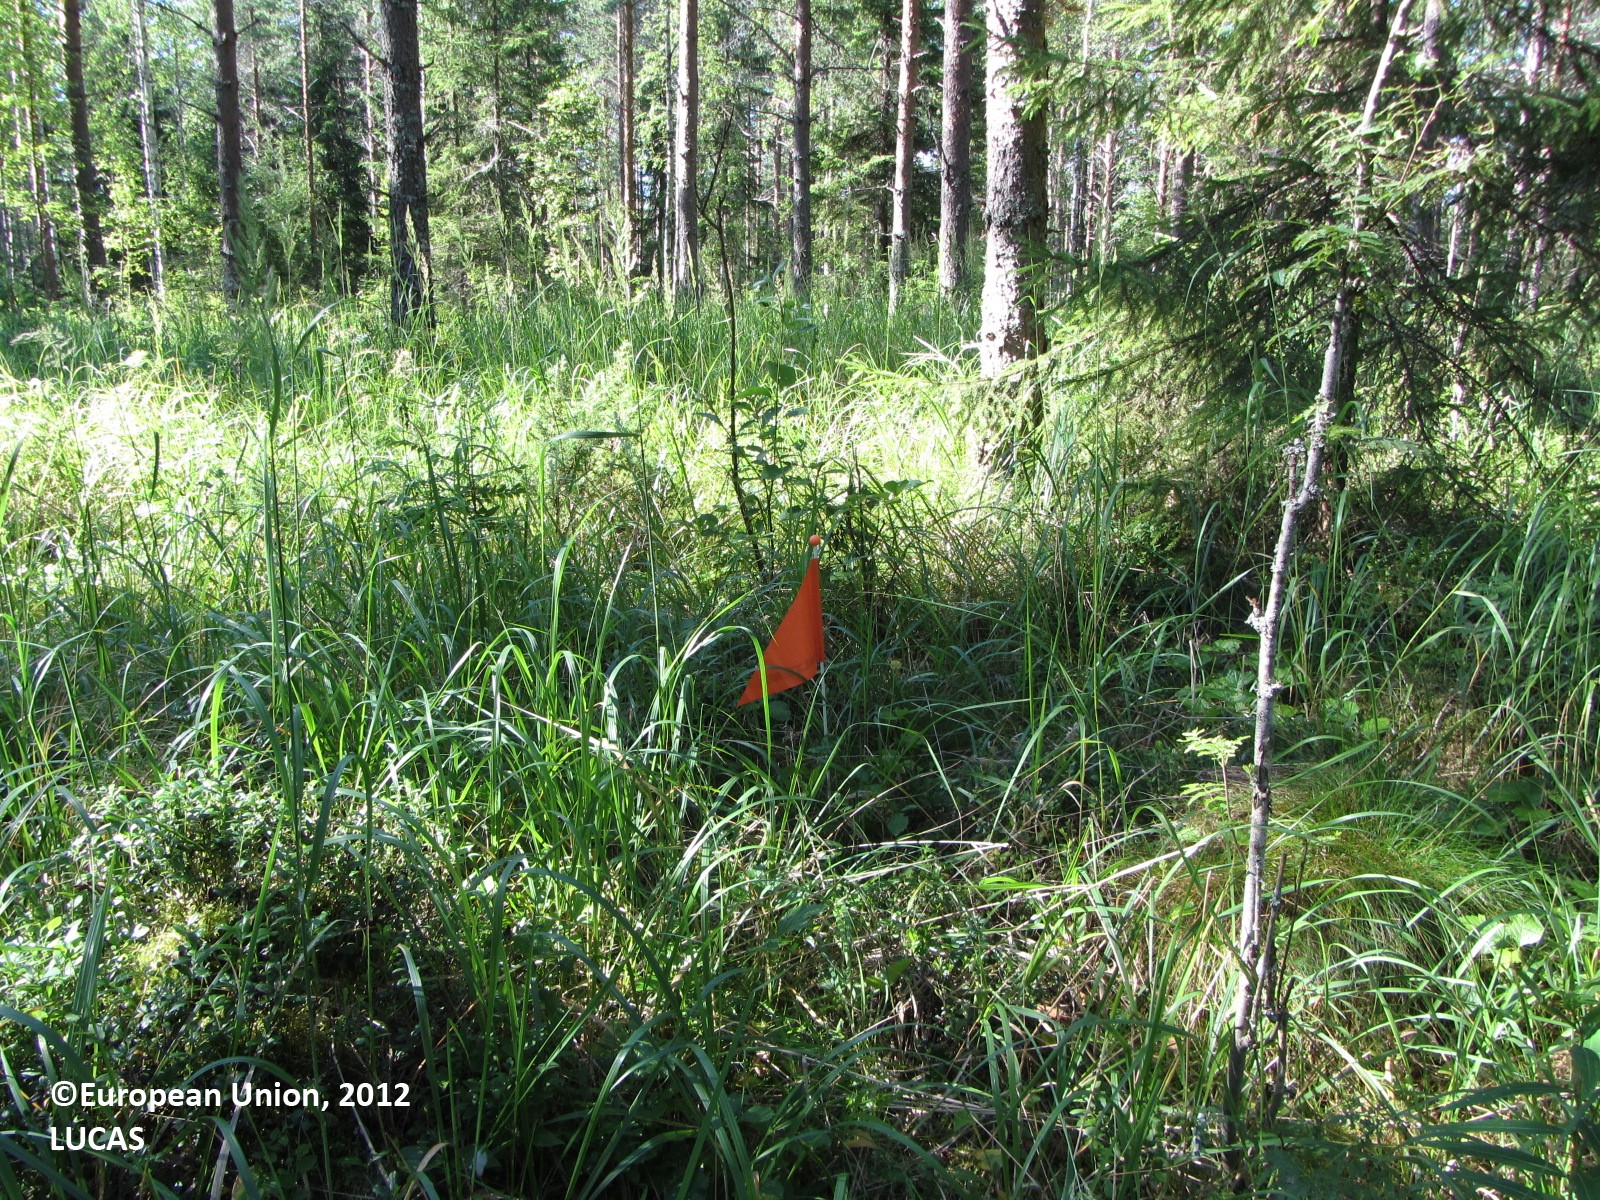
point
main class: Woodland
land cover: Pine dominated coniferous woodland
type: boreal forest
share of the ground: 50 - 75 %
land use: Forestry
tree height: > 5 m
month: July
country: FI
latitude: 63.6370
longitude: 24.6754
